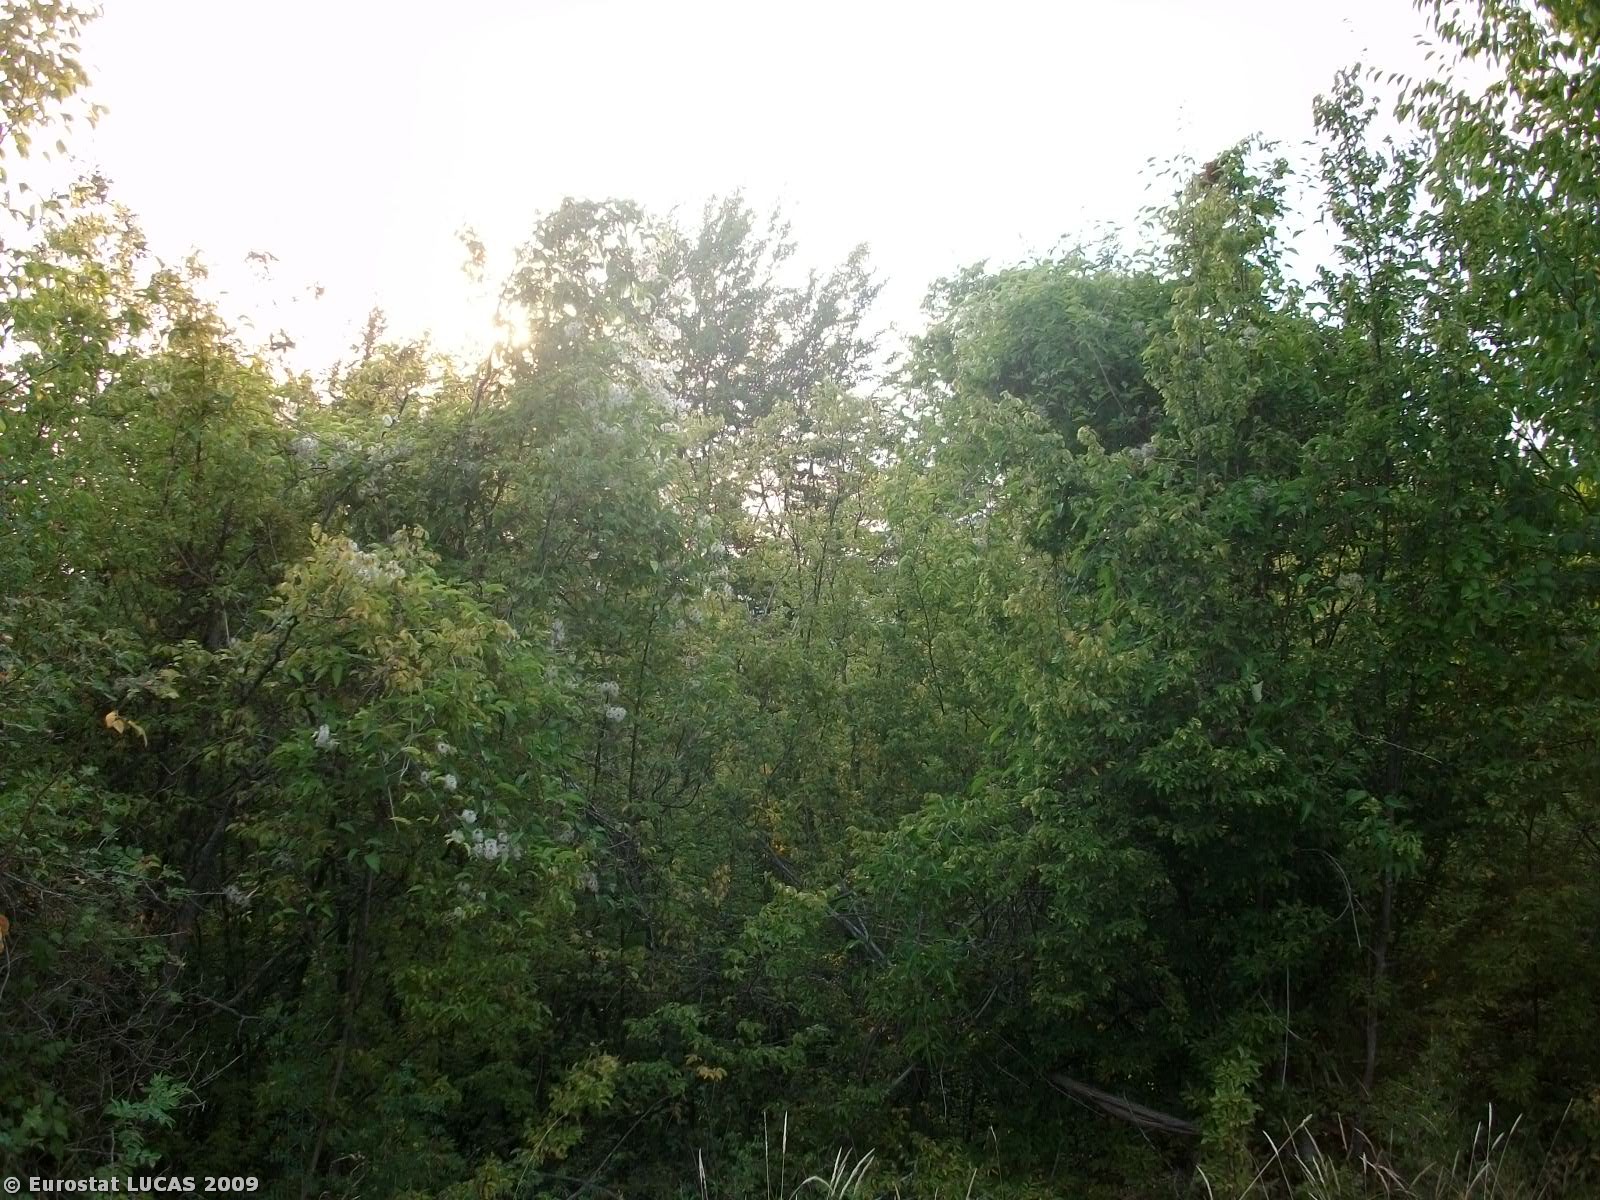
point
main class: Woodland
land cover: Broadleaved woodland
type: broadleaved evergreen forest
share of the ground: > 75 %
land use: Forestry
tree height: > 5 m
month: September
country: GR
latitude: 41.1514
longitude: 24.4645
